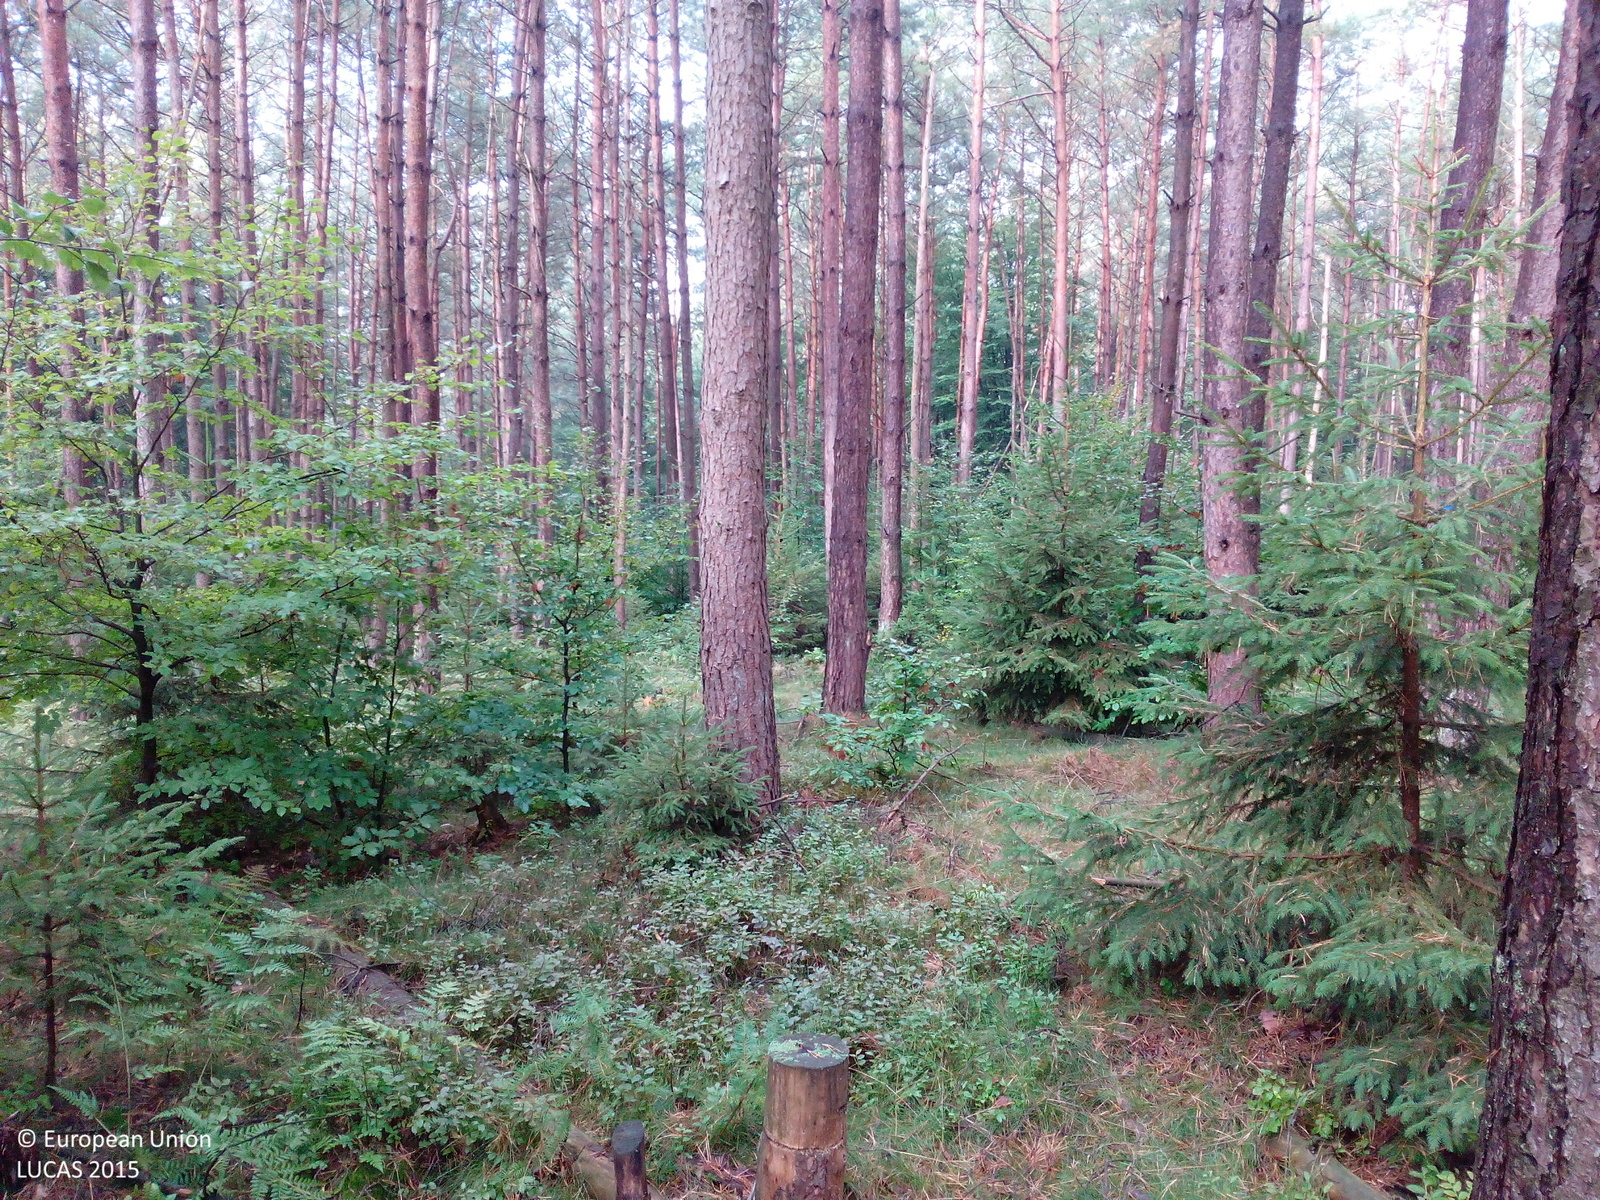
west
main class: Woodland
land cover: Other coniferous woodland
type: hemiboreal forest and nemoral coniferous forest and mixed broadleaved-coniferous forest
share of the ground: > 75 %
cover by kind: coniferous forest trees 70 %, broadleaved forest trees 20 %, shrubs 5 %, herbaceous plants 5 %
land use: Forestry
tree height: > 5 m
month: September
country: DE
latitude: 50.0388
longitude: 9.3998
